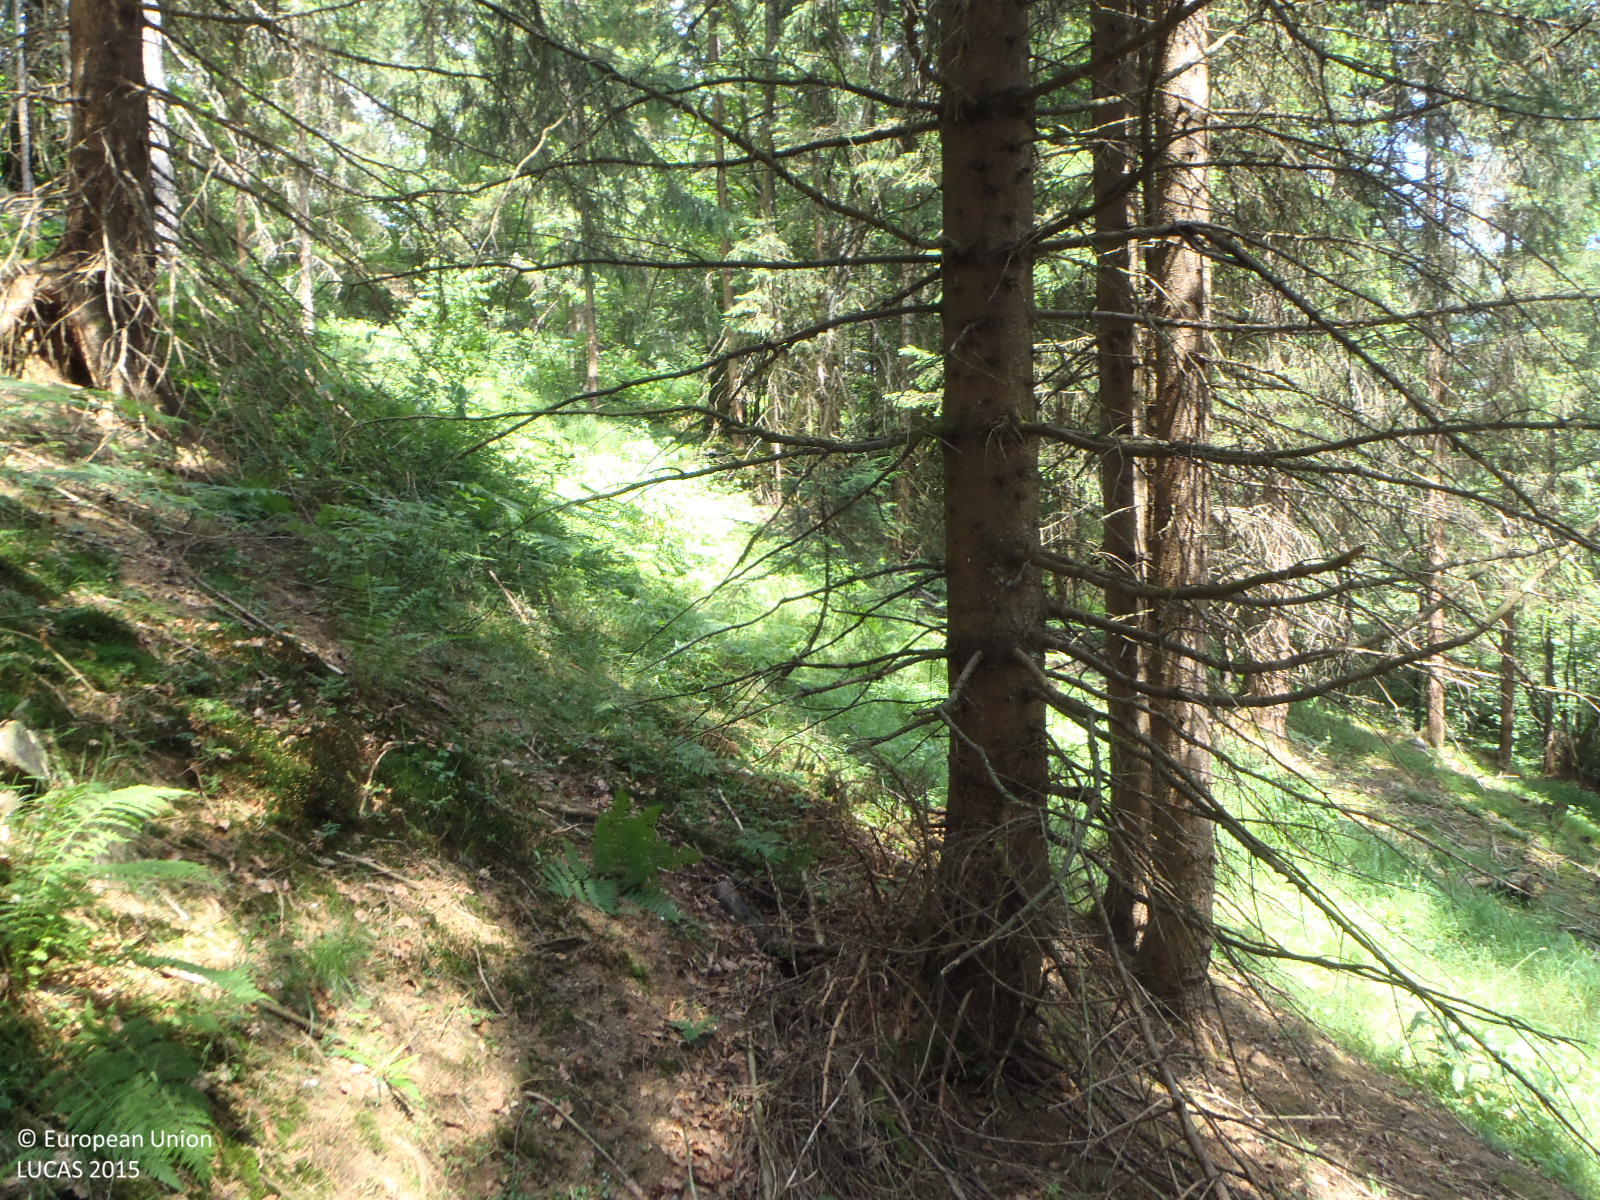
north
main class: Woodland
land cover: Spruce dominated coniferous woodland
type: alpine coniferous forest
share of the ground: > 75 %
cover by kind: coniferous forest trees 85 %, herbaceous plants 10 %, lichens and mosses 5 %
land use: Forestry
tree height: > 5 m
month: July
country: AT
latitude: 47.5486
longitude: 12.4300
